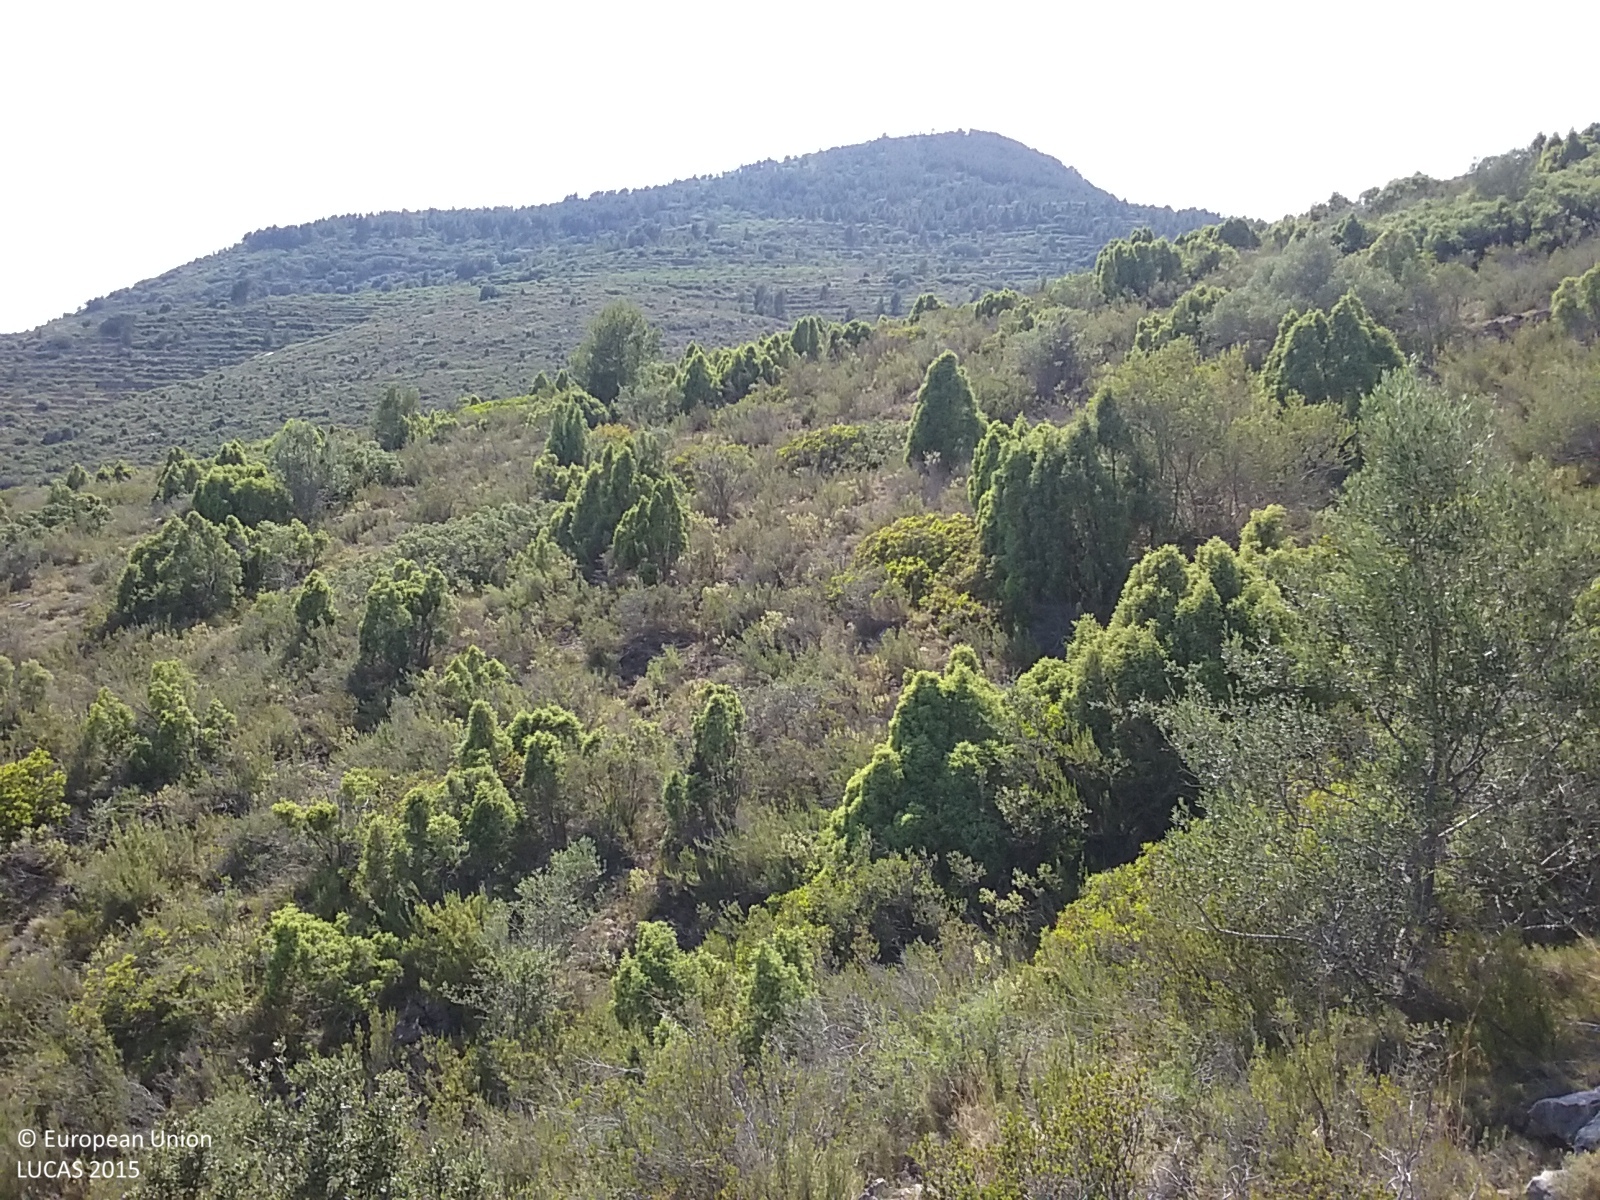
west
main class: Shrubland
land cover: Shrubland with sparse tree cover
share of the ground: > 75 %
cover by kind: shrubs 70 %, herbaceous plants 20 %, broadleaved forest trees 5 %
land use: Semi-natural and natural areas not in use
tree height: < 5 m
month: May
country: ES
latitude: 40.2666
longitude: 0.0131
